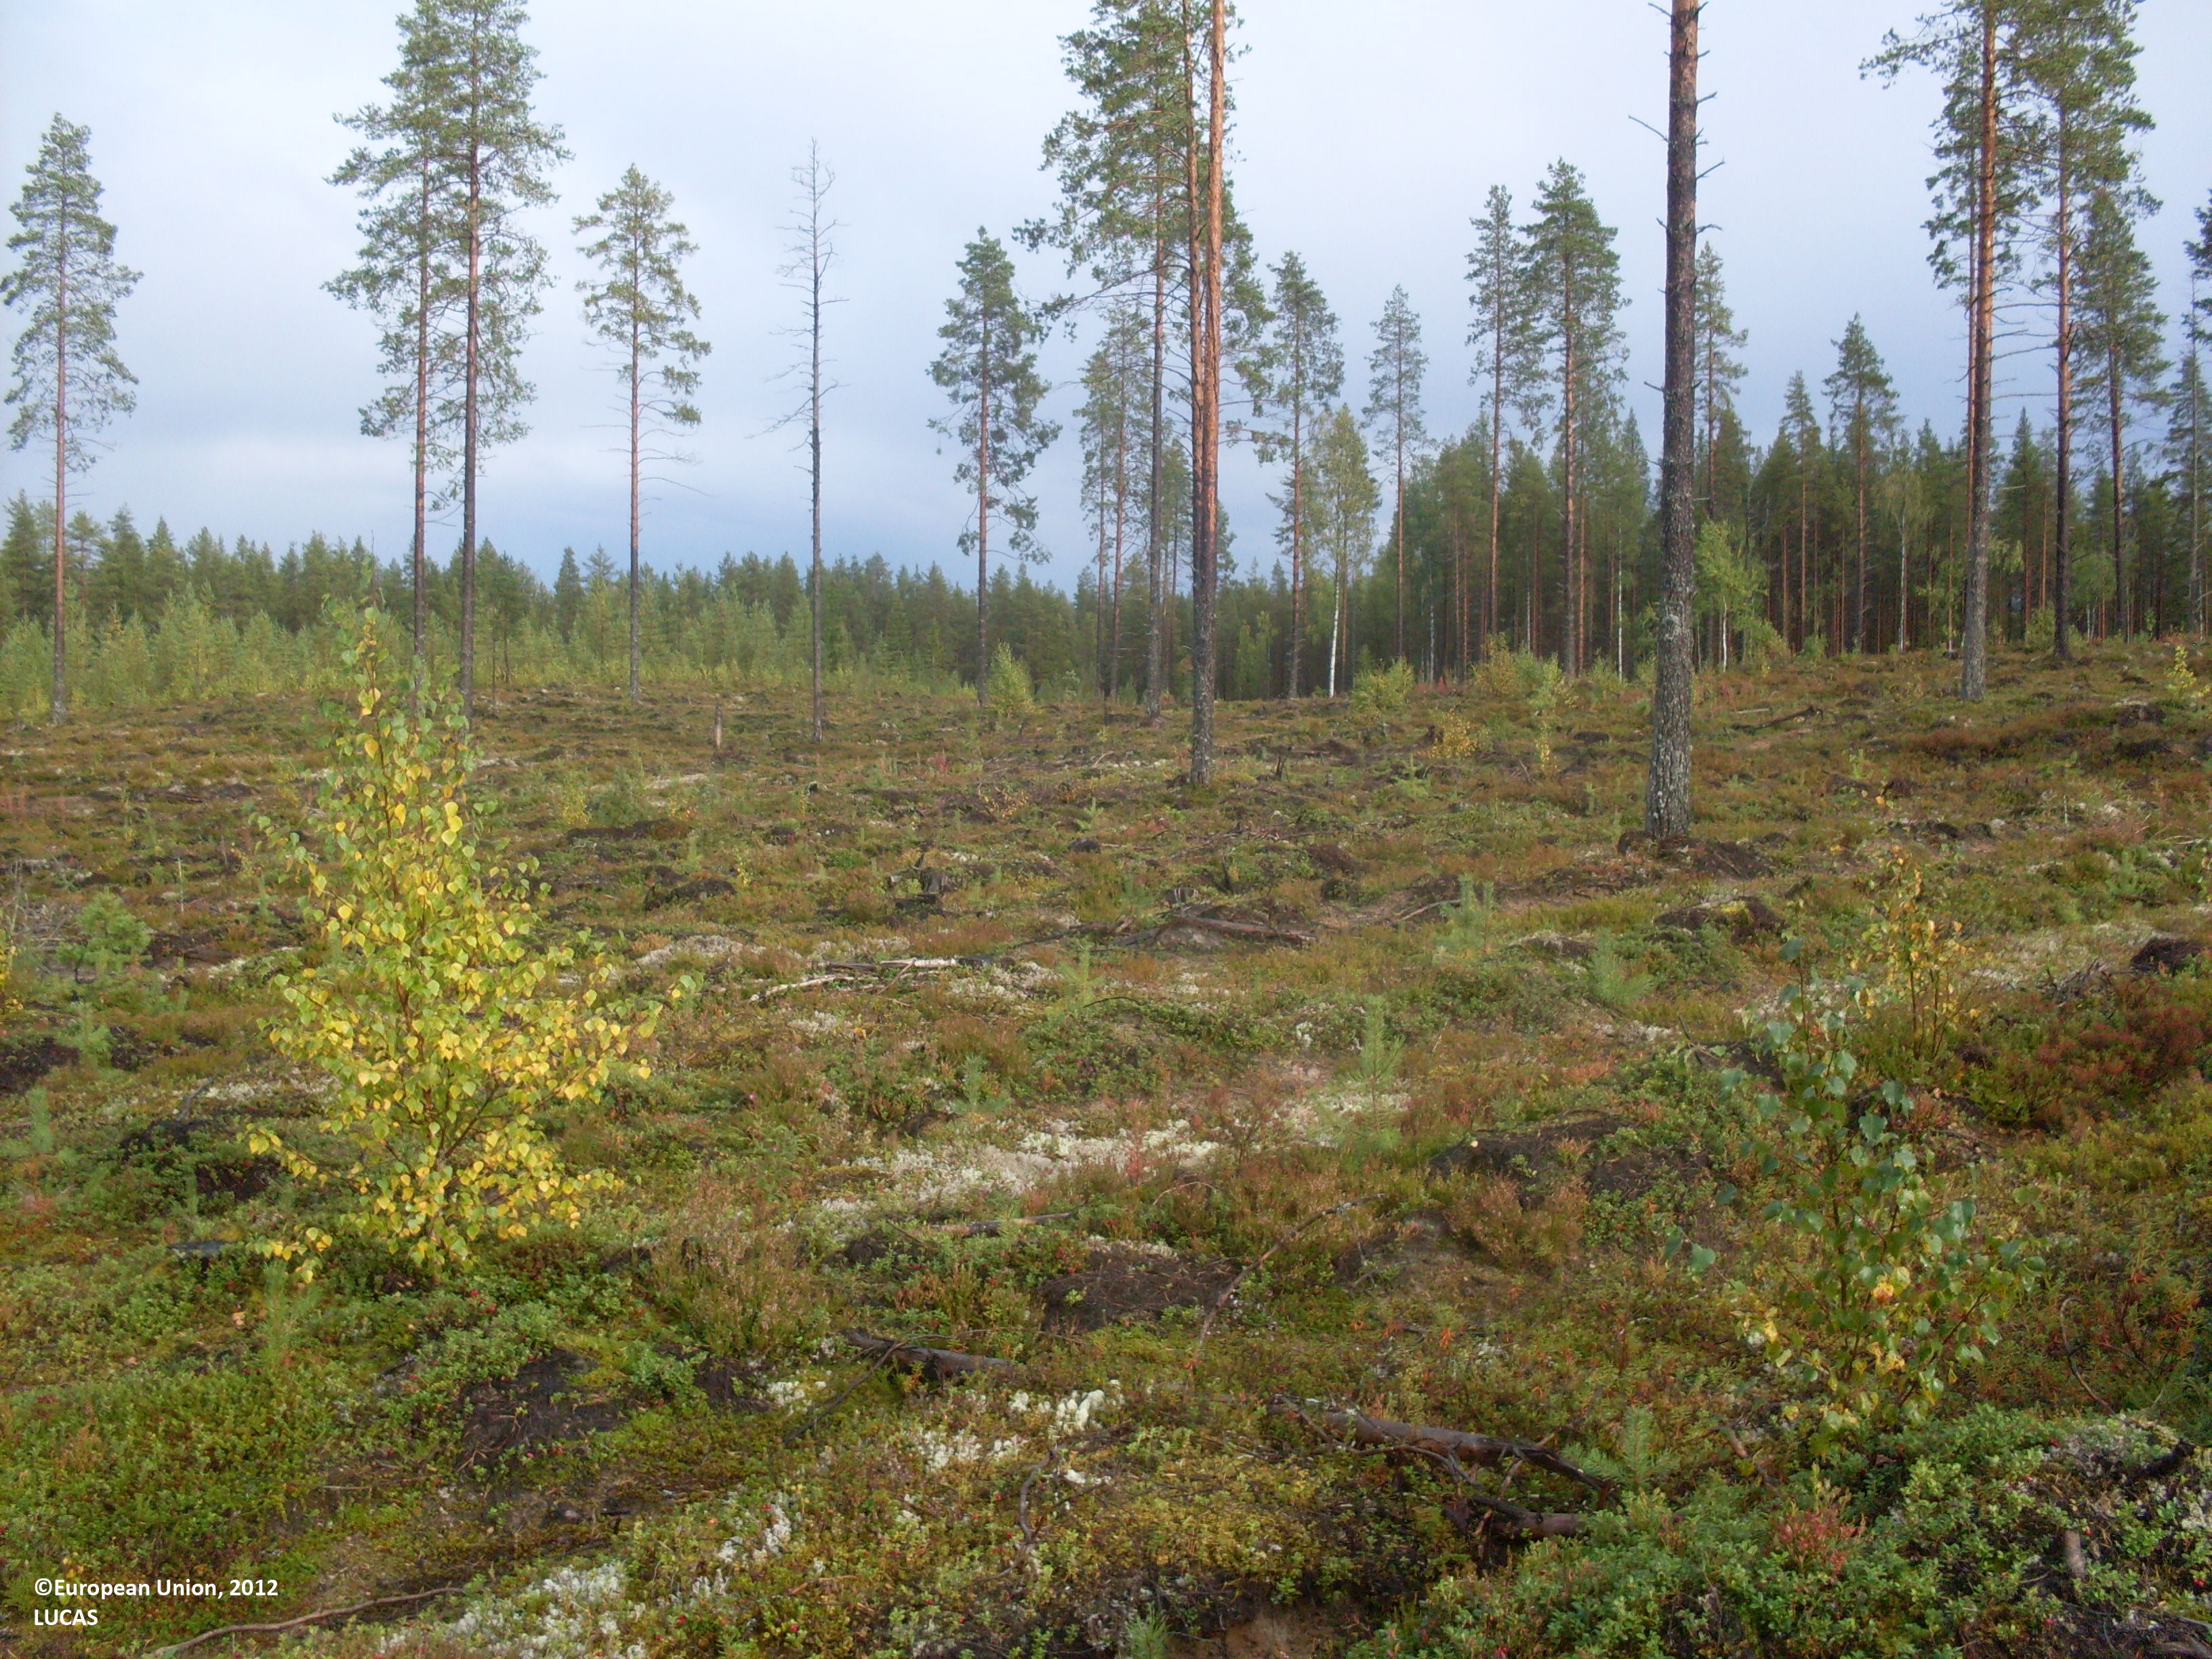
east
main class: Woodland
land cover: Pine dominated coniferous woodland
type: boreal forest
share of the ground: 10 - 25 %
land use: Forestry
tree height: < 5 m
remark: Nursery
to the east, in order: Pine dominated coniferous woodland; Ditches and canals; Pine dominated coniferous woodland
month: September
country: FI
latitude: 64.1570
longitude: 29.8264
